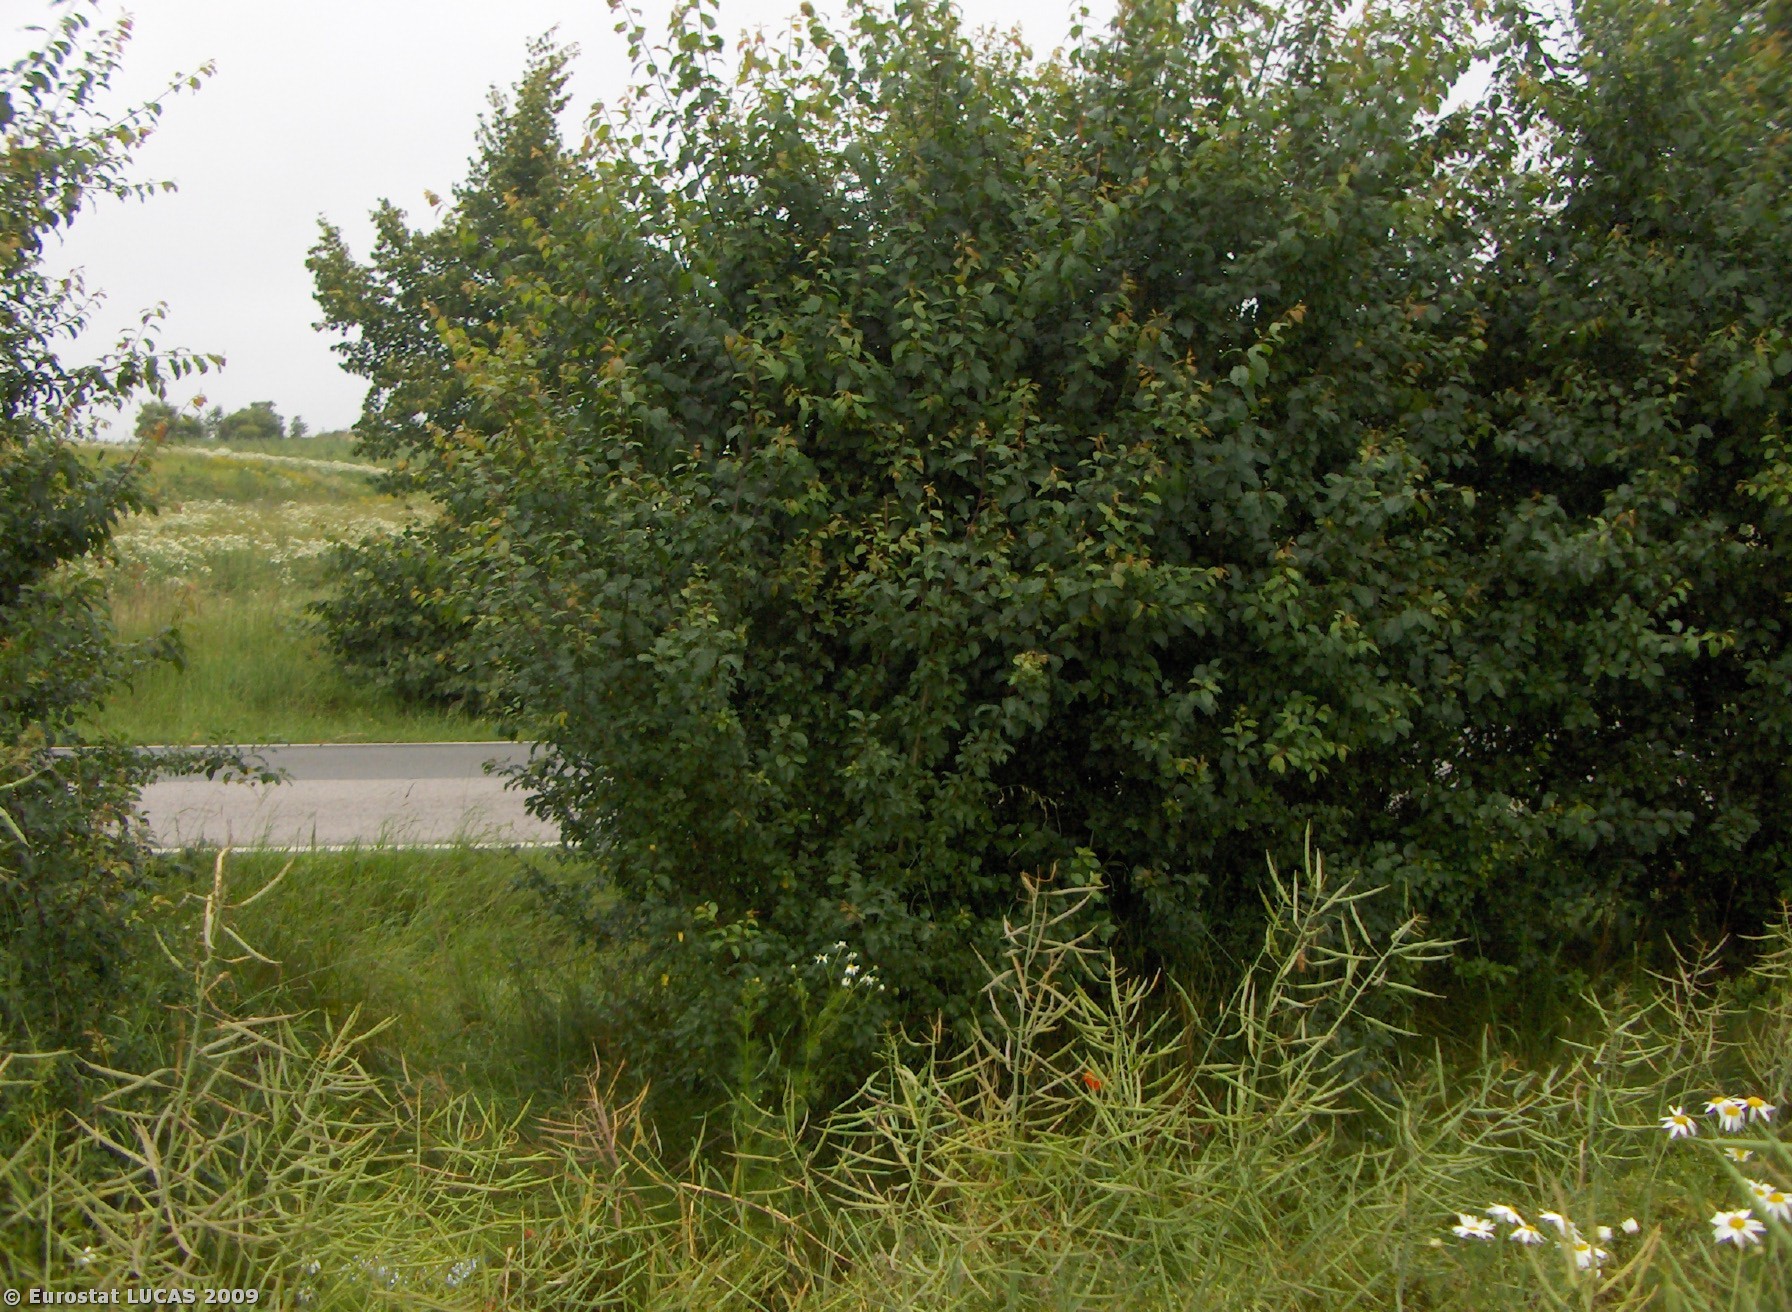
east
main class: Cropland
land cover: Rape and turnip rape
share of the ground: > 75 %
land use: Agriculture (excluding fallow land and kitchen gardens)
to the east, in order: Rape and turnip rape; Electric lines; Lines of trees; Ditches and canals; Paved roads, cycling and walking lanes; Shrubland without tree cover; Rape and turnip rape; Electric lines; Rape and turnip rape
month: June
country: CZ
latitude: 49.6917
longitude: 14.2291
